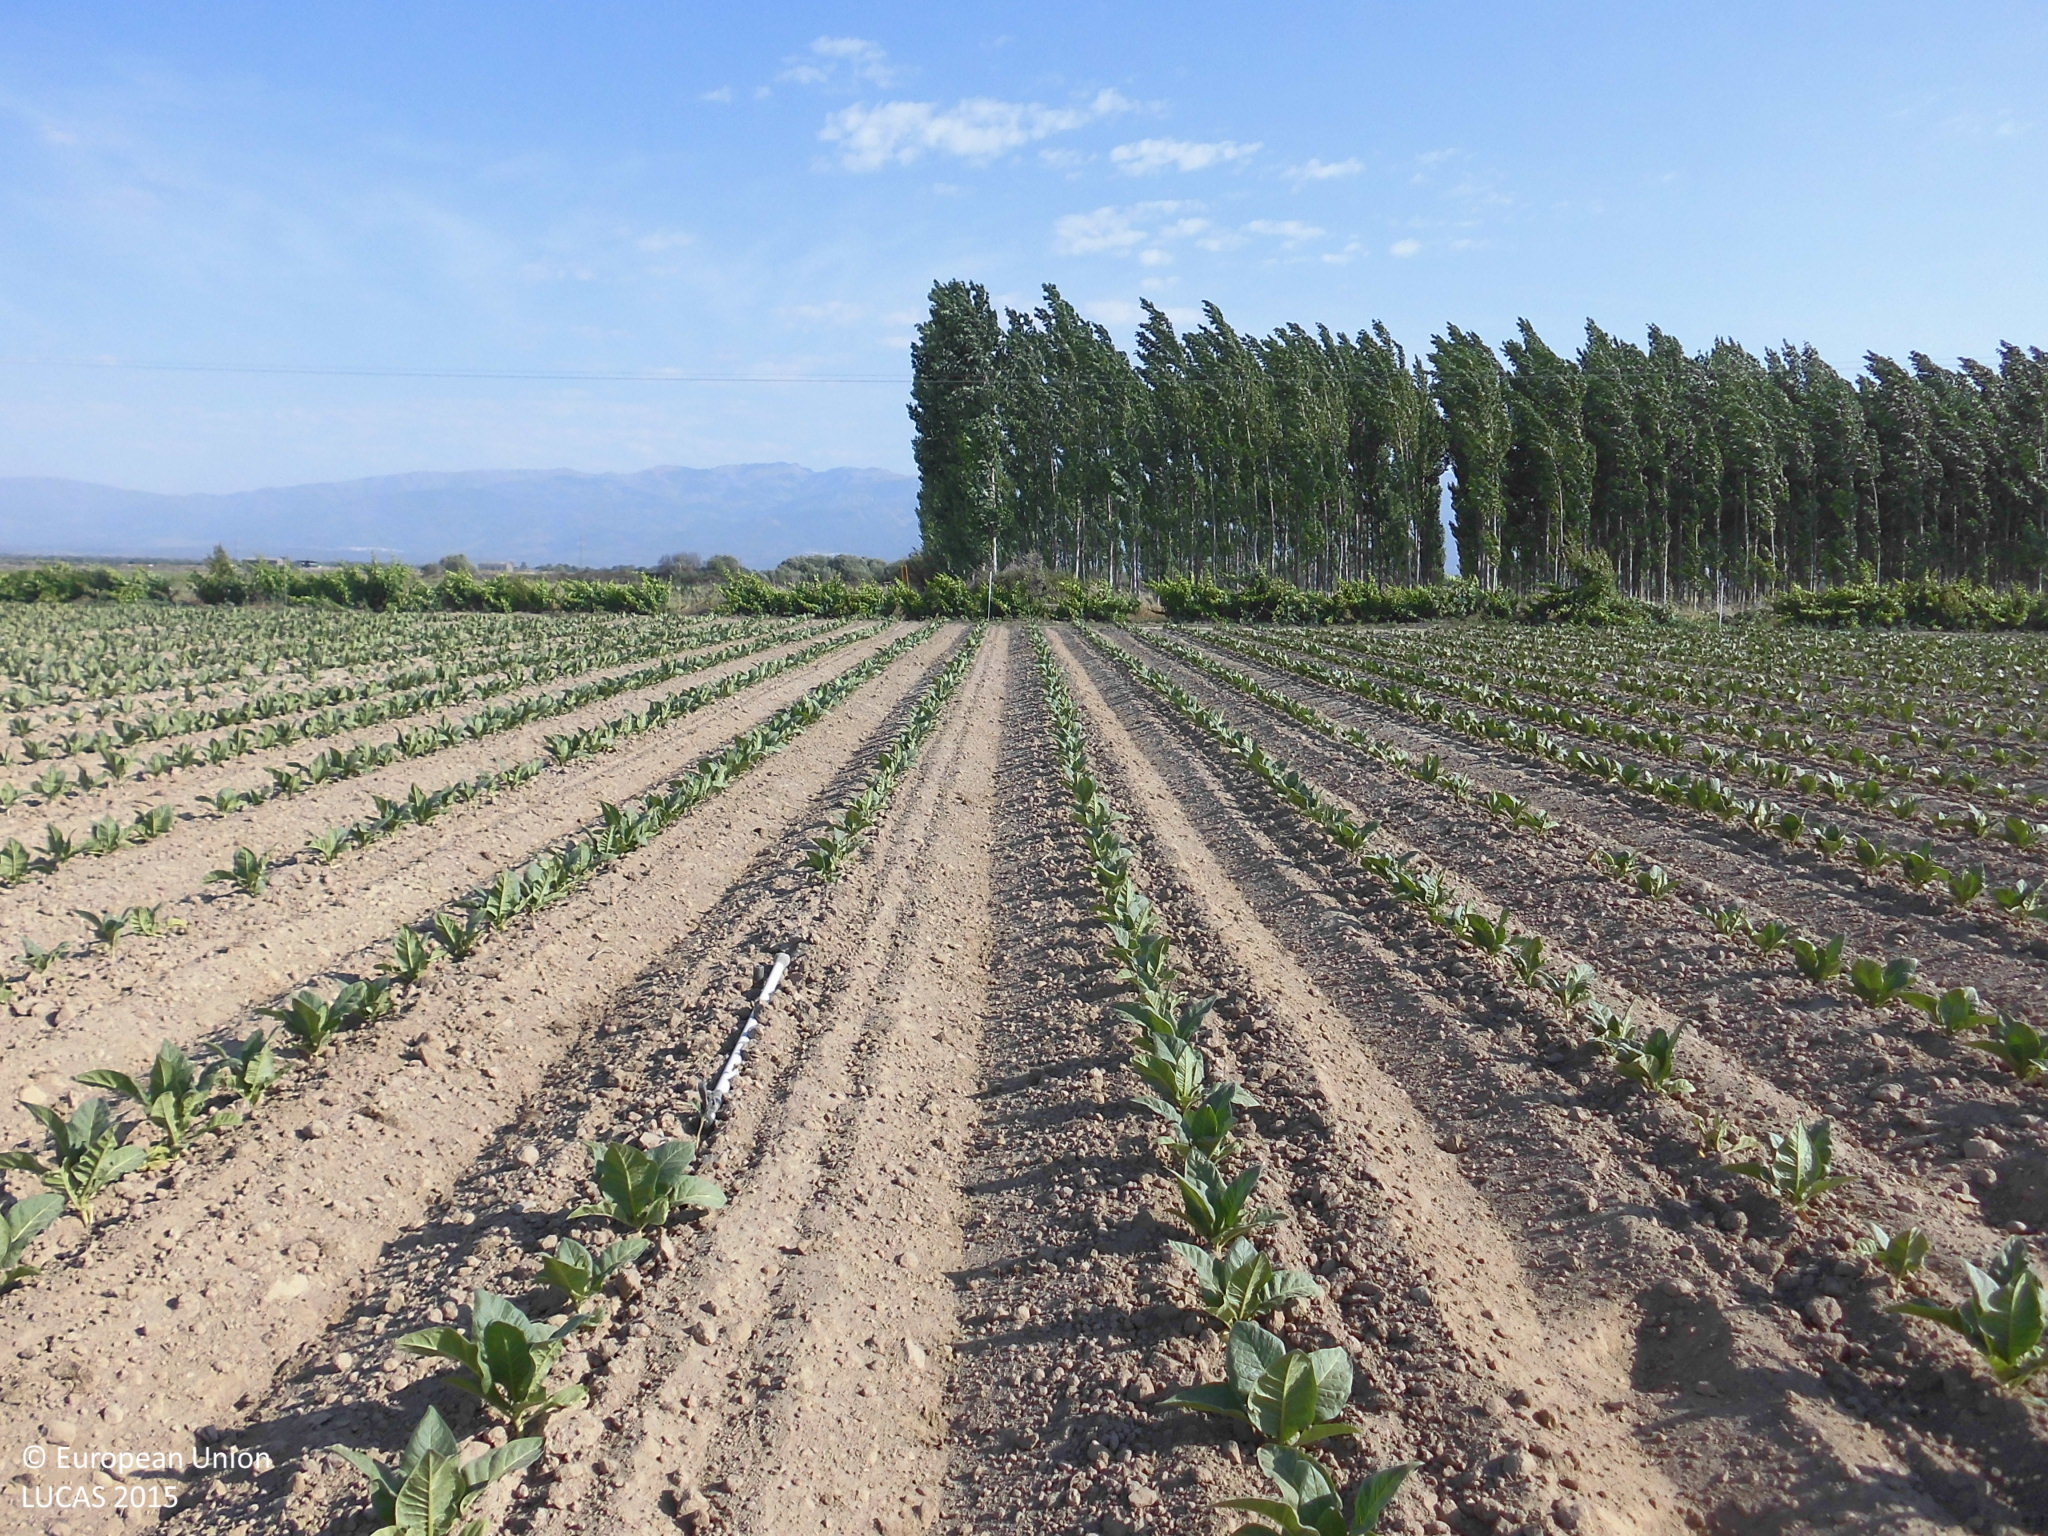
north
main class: Cropland
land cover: Tobacco
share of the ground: 10 - 25 %
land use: Agriculture (excluding fallow land and kitchen gardens)
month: June
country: ES
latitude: 39.9718
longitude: -5.4552
